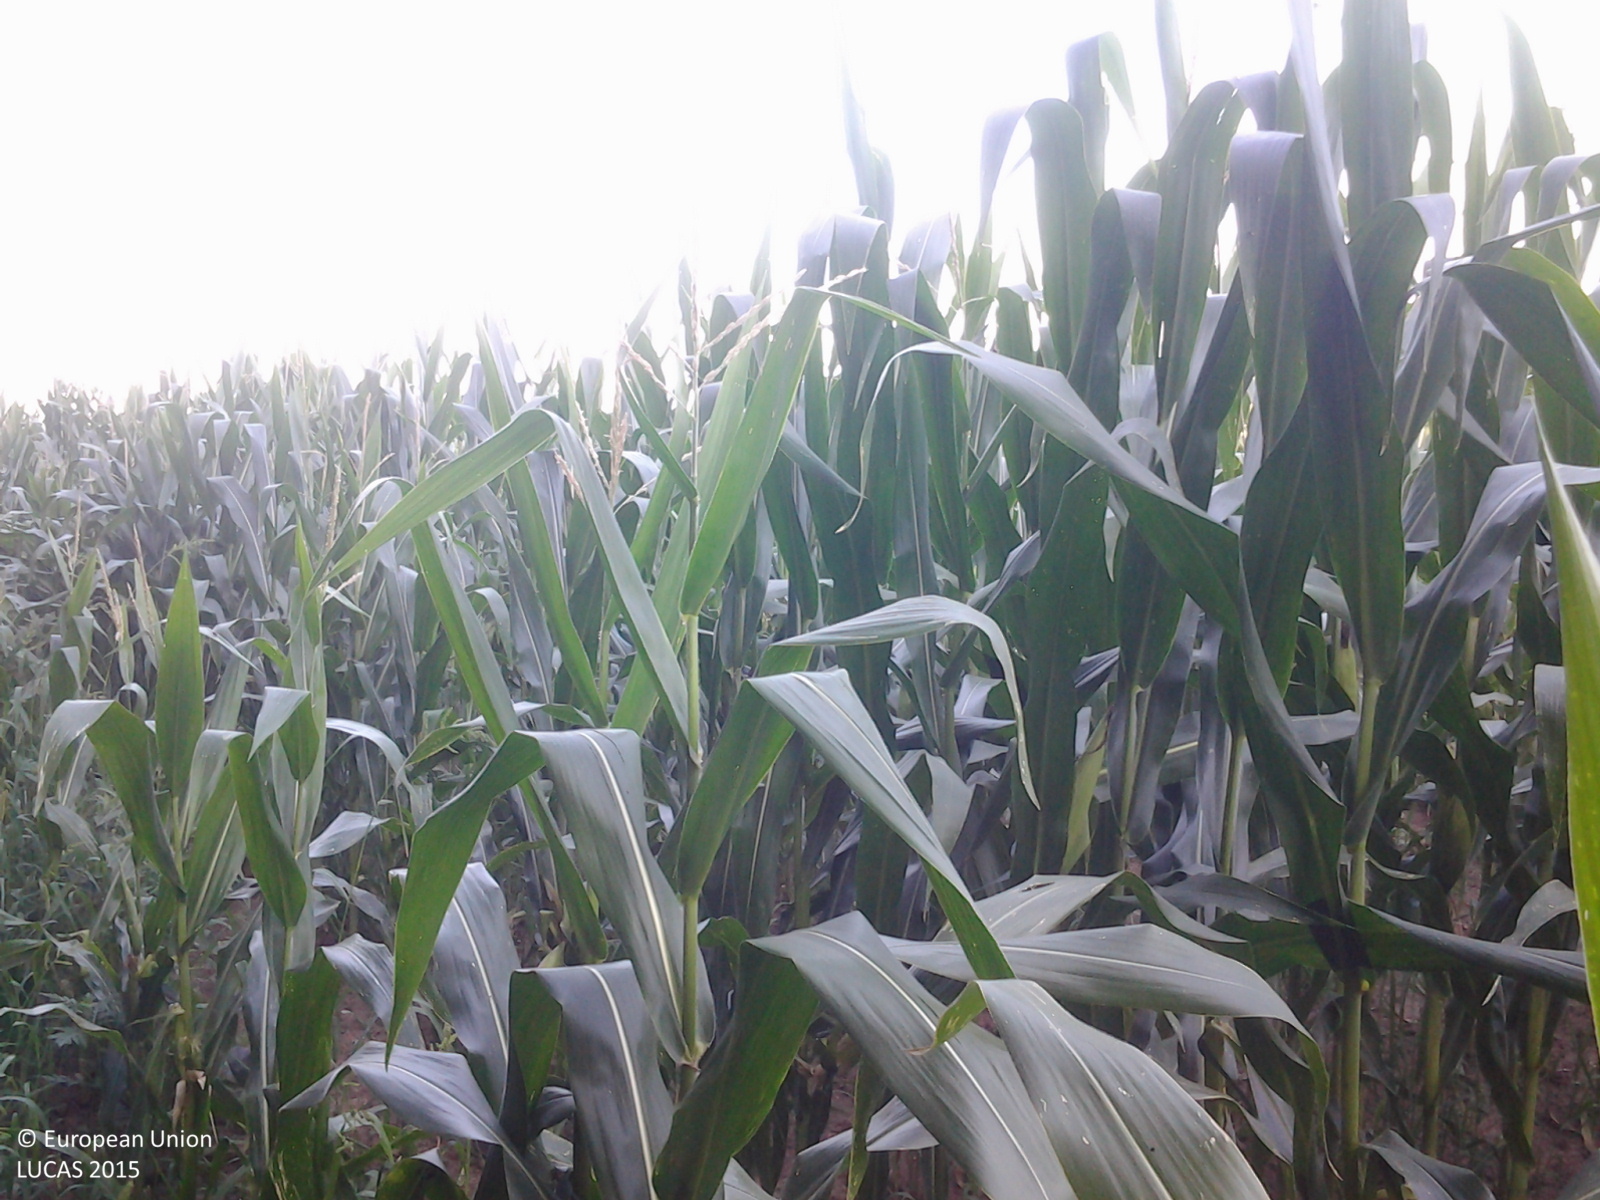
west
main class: Cropland
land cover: Maize
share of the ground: > 75 %
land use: Agriculture (excluding fallow land and kitchen gardens)
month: August
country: HU
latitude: 46.8954
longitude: 21.4719
